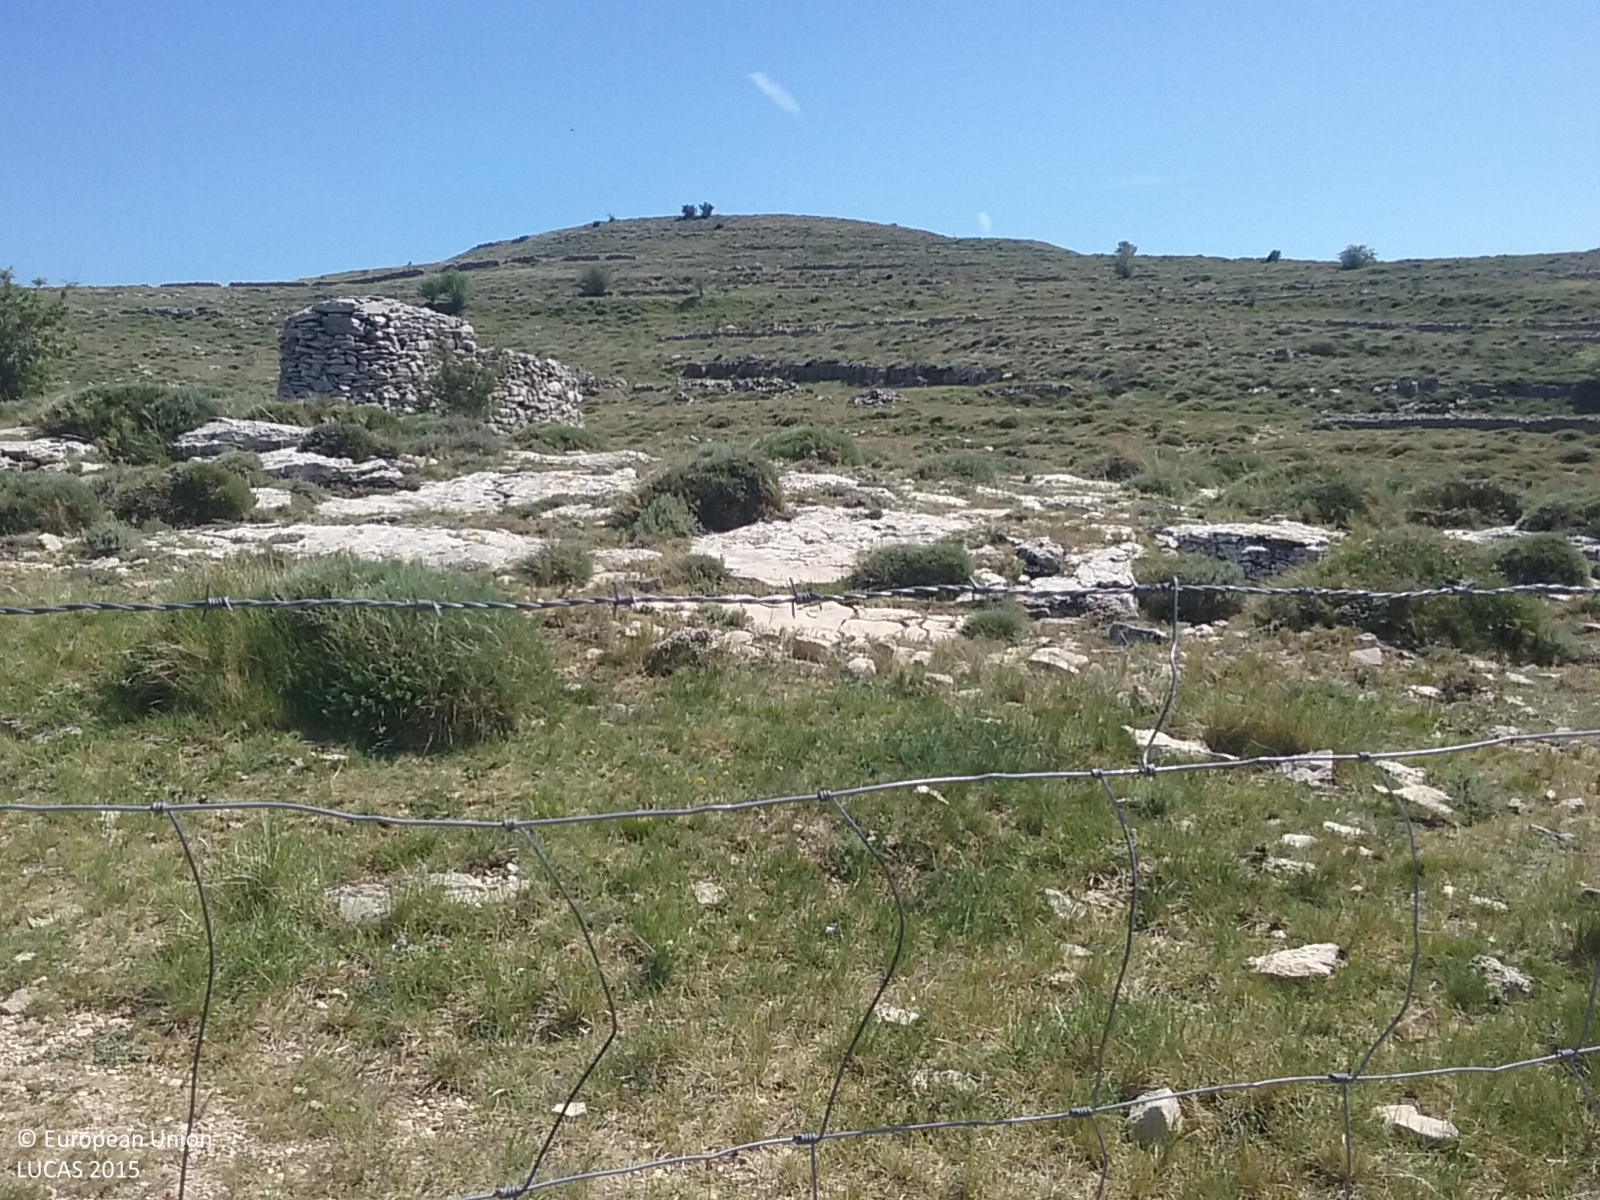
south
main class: Grassland
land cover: Grassland without tree/shrub cover
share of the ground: 25 - 50 %
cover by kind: herbaceous plants 20 %
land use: Abandoned areas
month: May
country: ES
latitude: 40.4589
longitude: -0.0647
